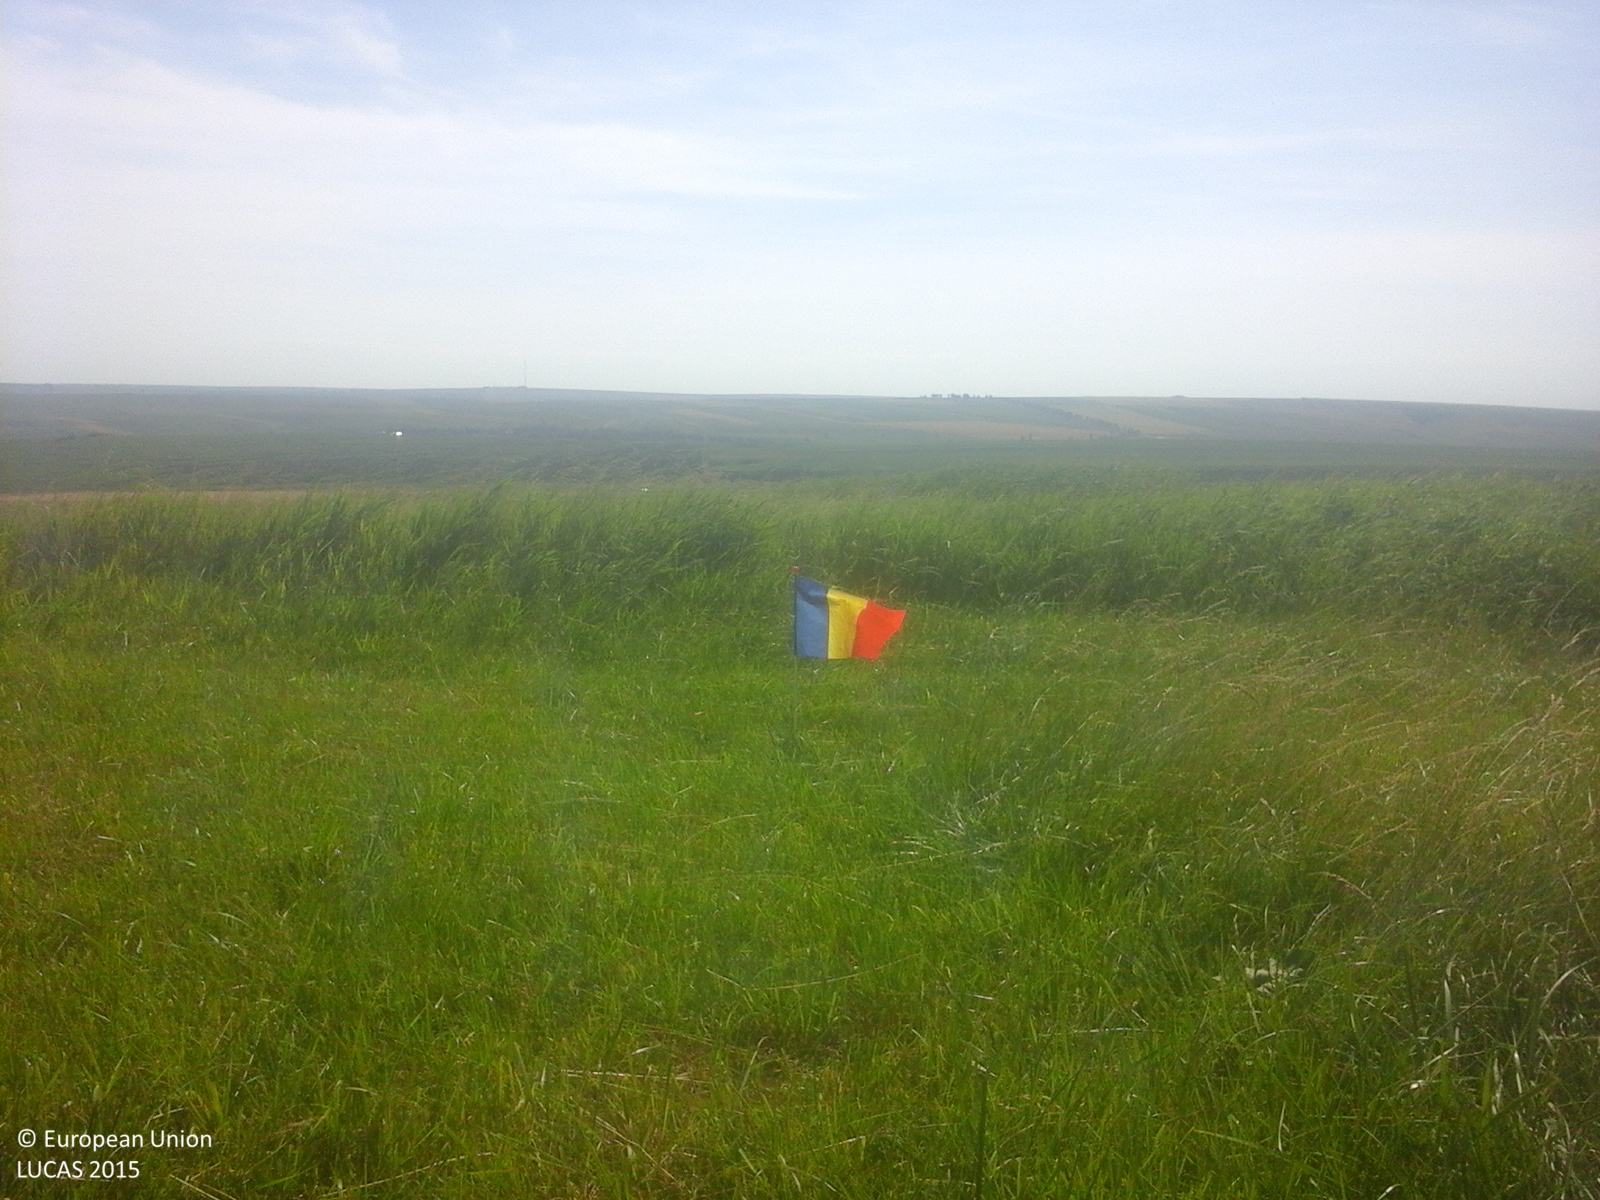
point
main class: Grassland
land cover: Grassland without tree/shrub cover
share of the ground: > 75 %
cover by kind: herbaceous plants 100 %
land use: Agriculture (excluding fallow land and kitchen gardens)
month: June
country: RO
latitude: 47.9834
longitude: 26.9464
